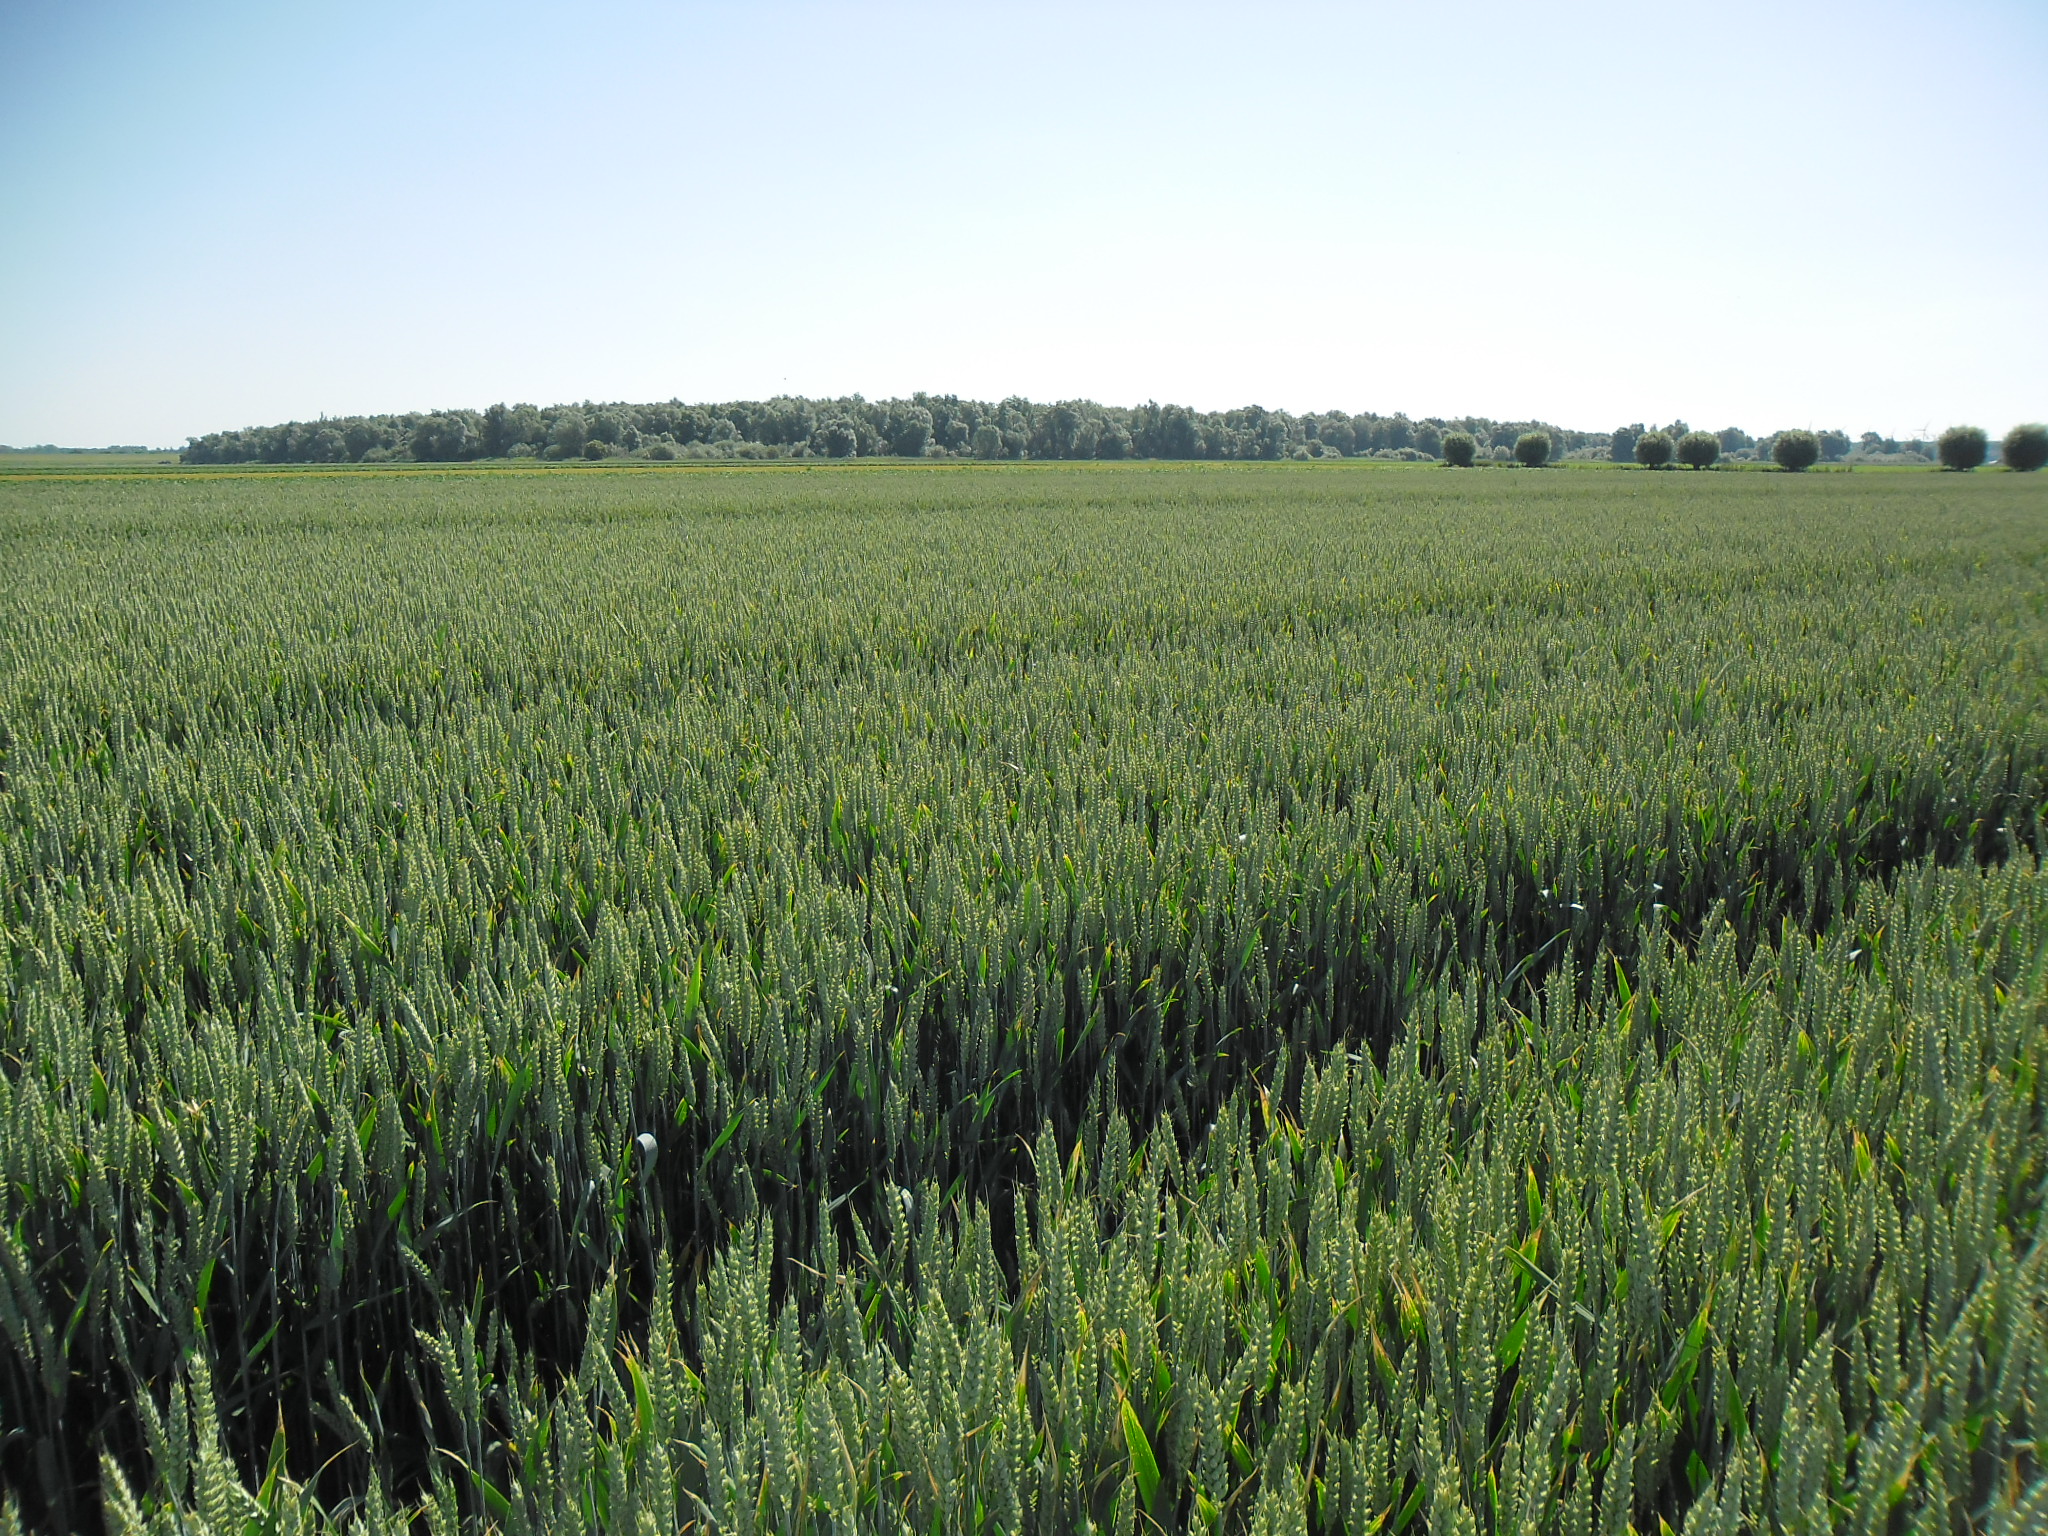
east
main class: Cropland
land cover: Common wheat
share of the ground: > 75 %
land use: Agriculture (excluding fallow land and kitchen gardens)
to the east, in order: Common wheat; Potatoes; Floriculture and ornamental plants
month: June
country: NL
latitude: 52.4165
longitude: 5.4551
